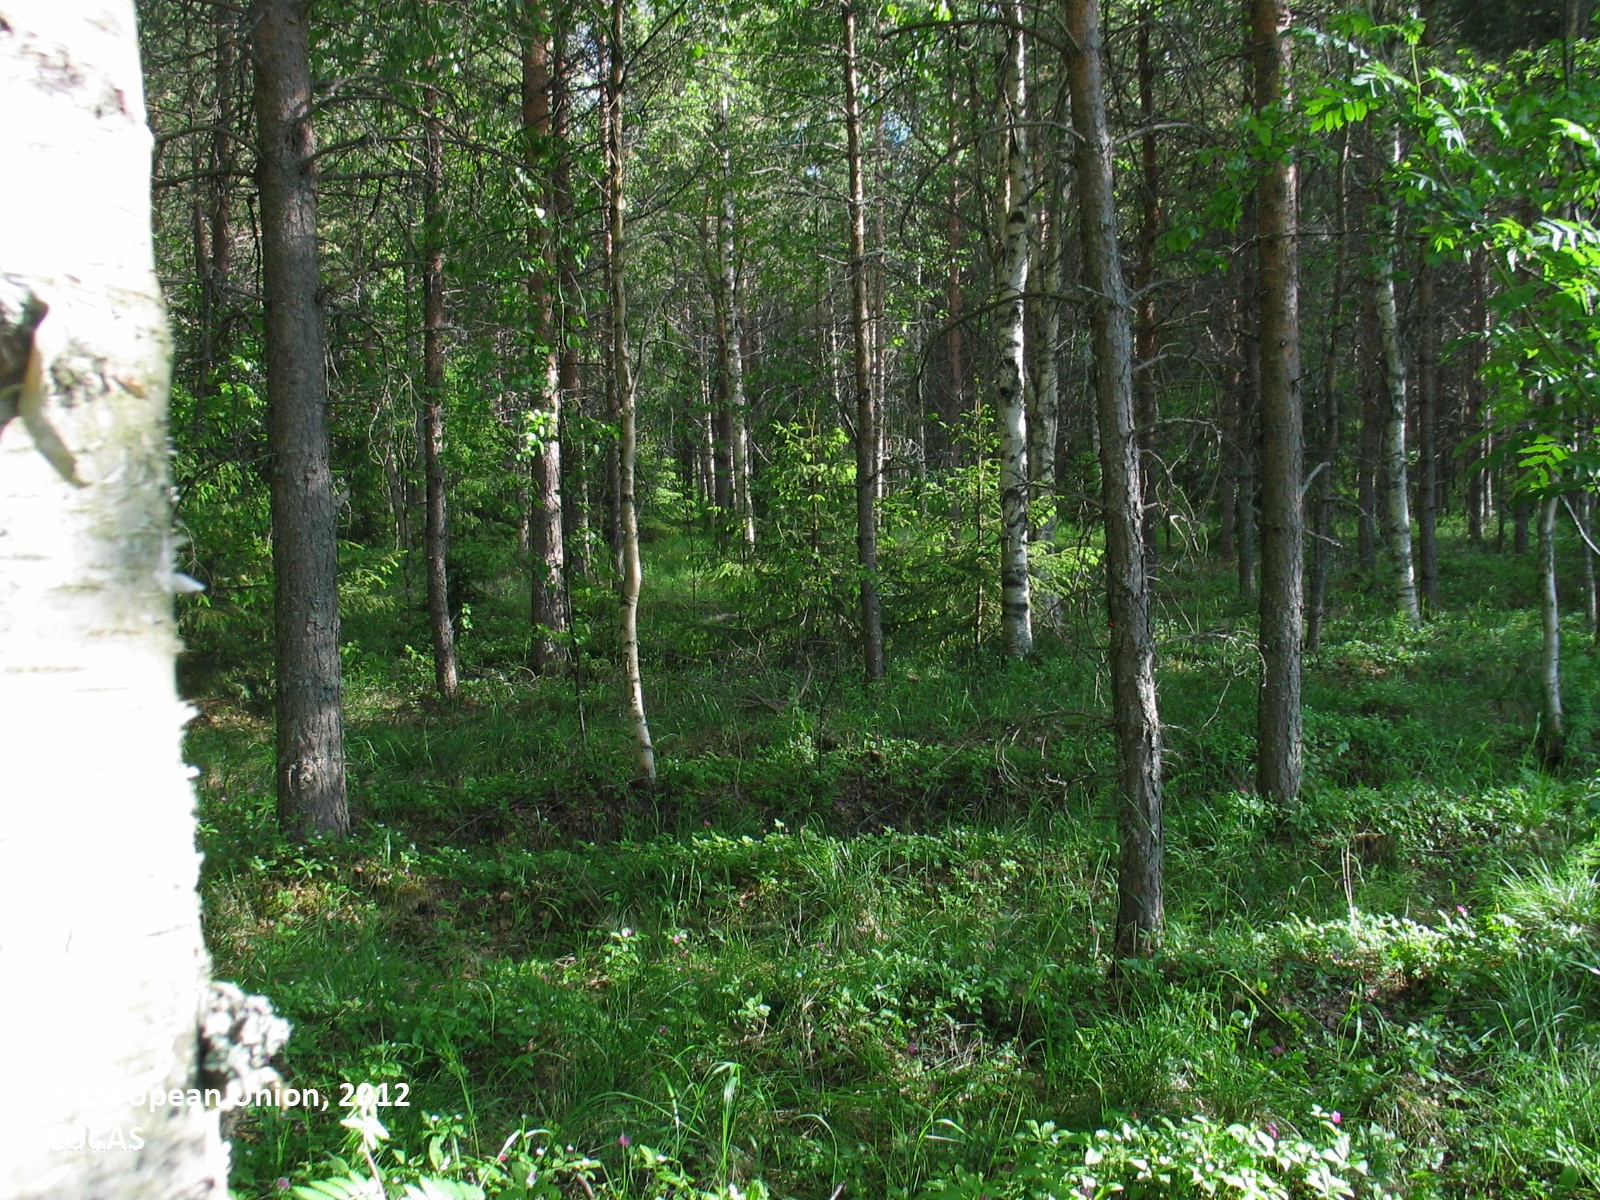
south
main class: Woodland
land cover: Broadleaved woodland
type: boreal forest
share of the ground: 50 - 75 %
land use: Forestry
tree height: > 5 m
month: June
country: FI
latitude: 65.1545
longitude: 25.4162
